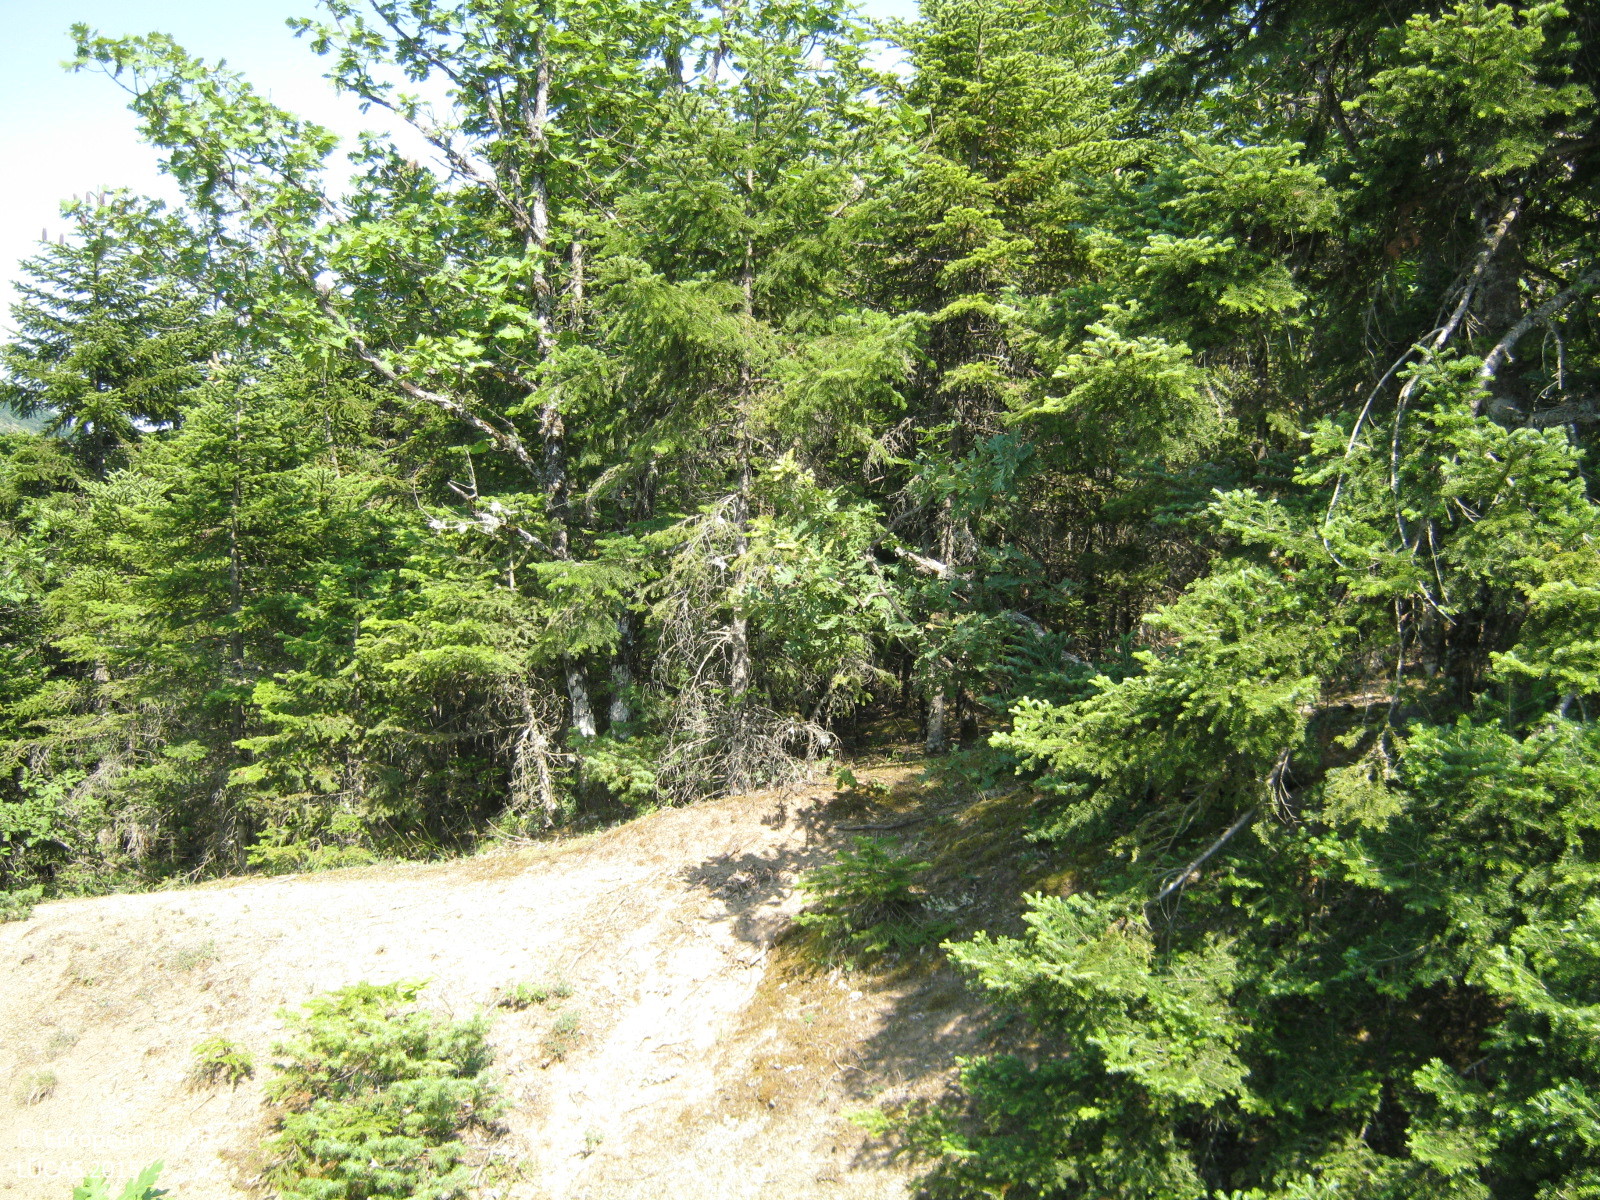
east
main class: Woodland
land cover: Spruce dominated mixed woodland
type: coniferous forest of the mediterranean region
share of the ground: > 75 %
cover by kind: coniferous forest trees 50 %, broadleaved forest trees 30 %, herbaceous plants 10 %, unconsolidated bare surface 10 %
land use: Forestry
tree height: > 5 m
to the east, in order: Spruce dominated mixed woodland; Grassland with sparse tree/shrub cover; Spruce dominated mixed woodland; Tracks; Grassland with sparse tree/shrub cover; Spruce dominated mixed woodland; Grassland without tree/shrub cover
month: July
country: GR
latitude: 39.2257
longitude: 21.7832
